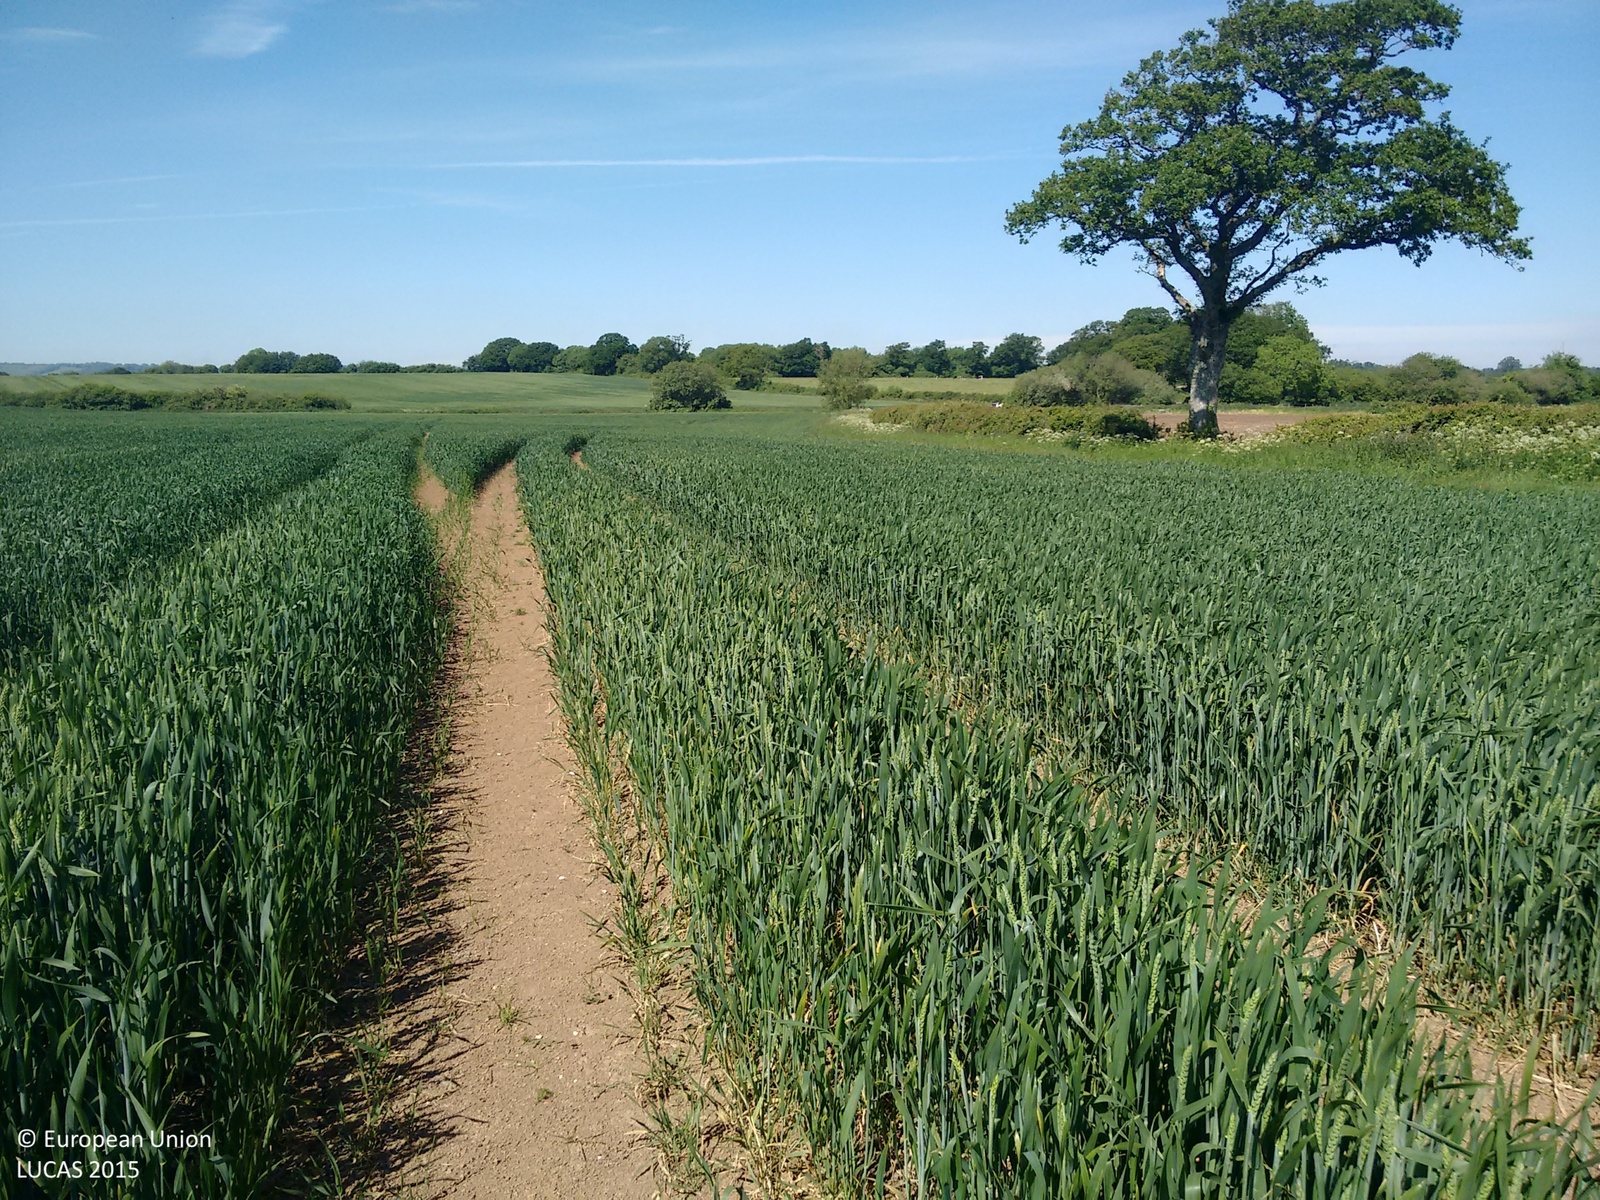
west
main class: Cropland
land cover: Common wheat
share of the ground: > 75 %
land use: Agriculture (excluding fallow land and kitchen gardens)
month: June
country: GB
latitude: 50.8706
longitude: -2.3845
